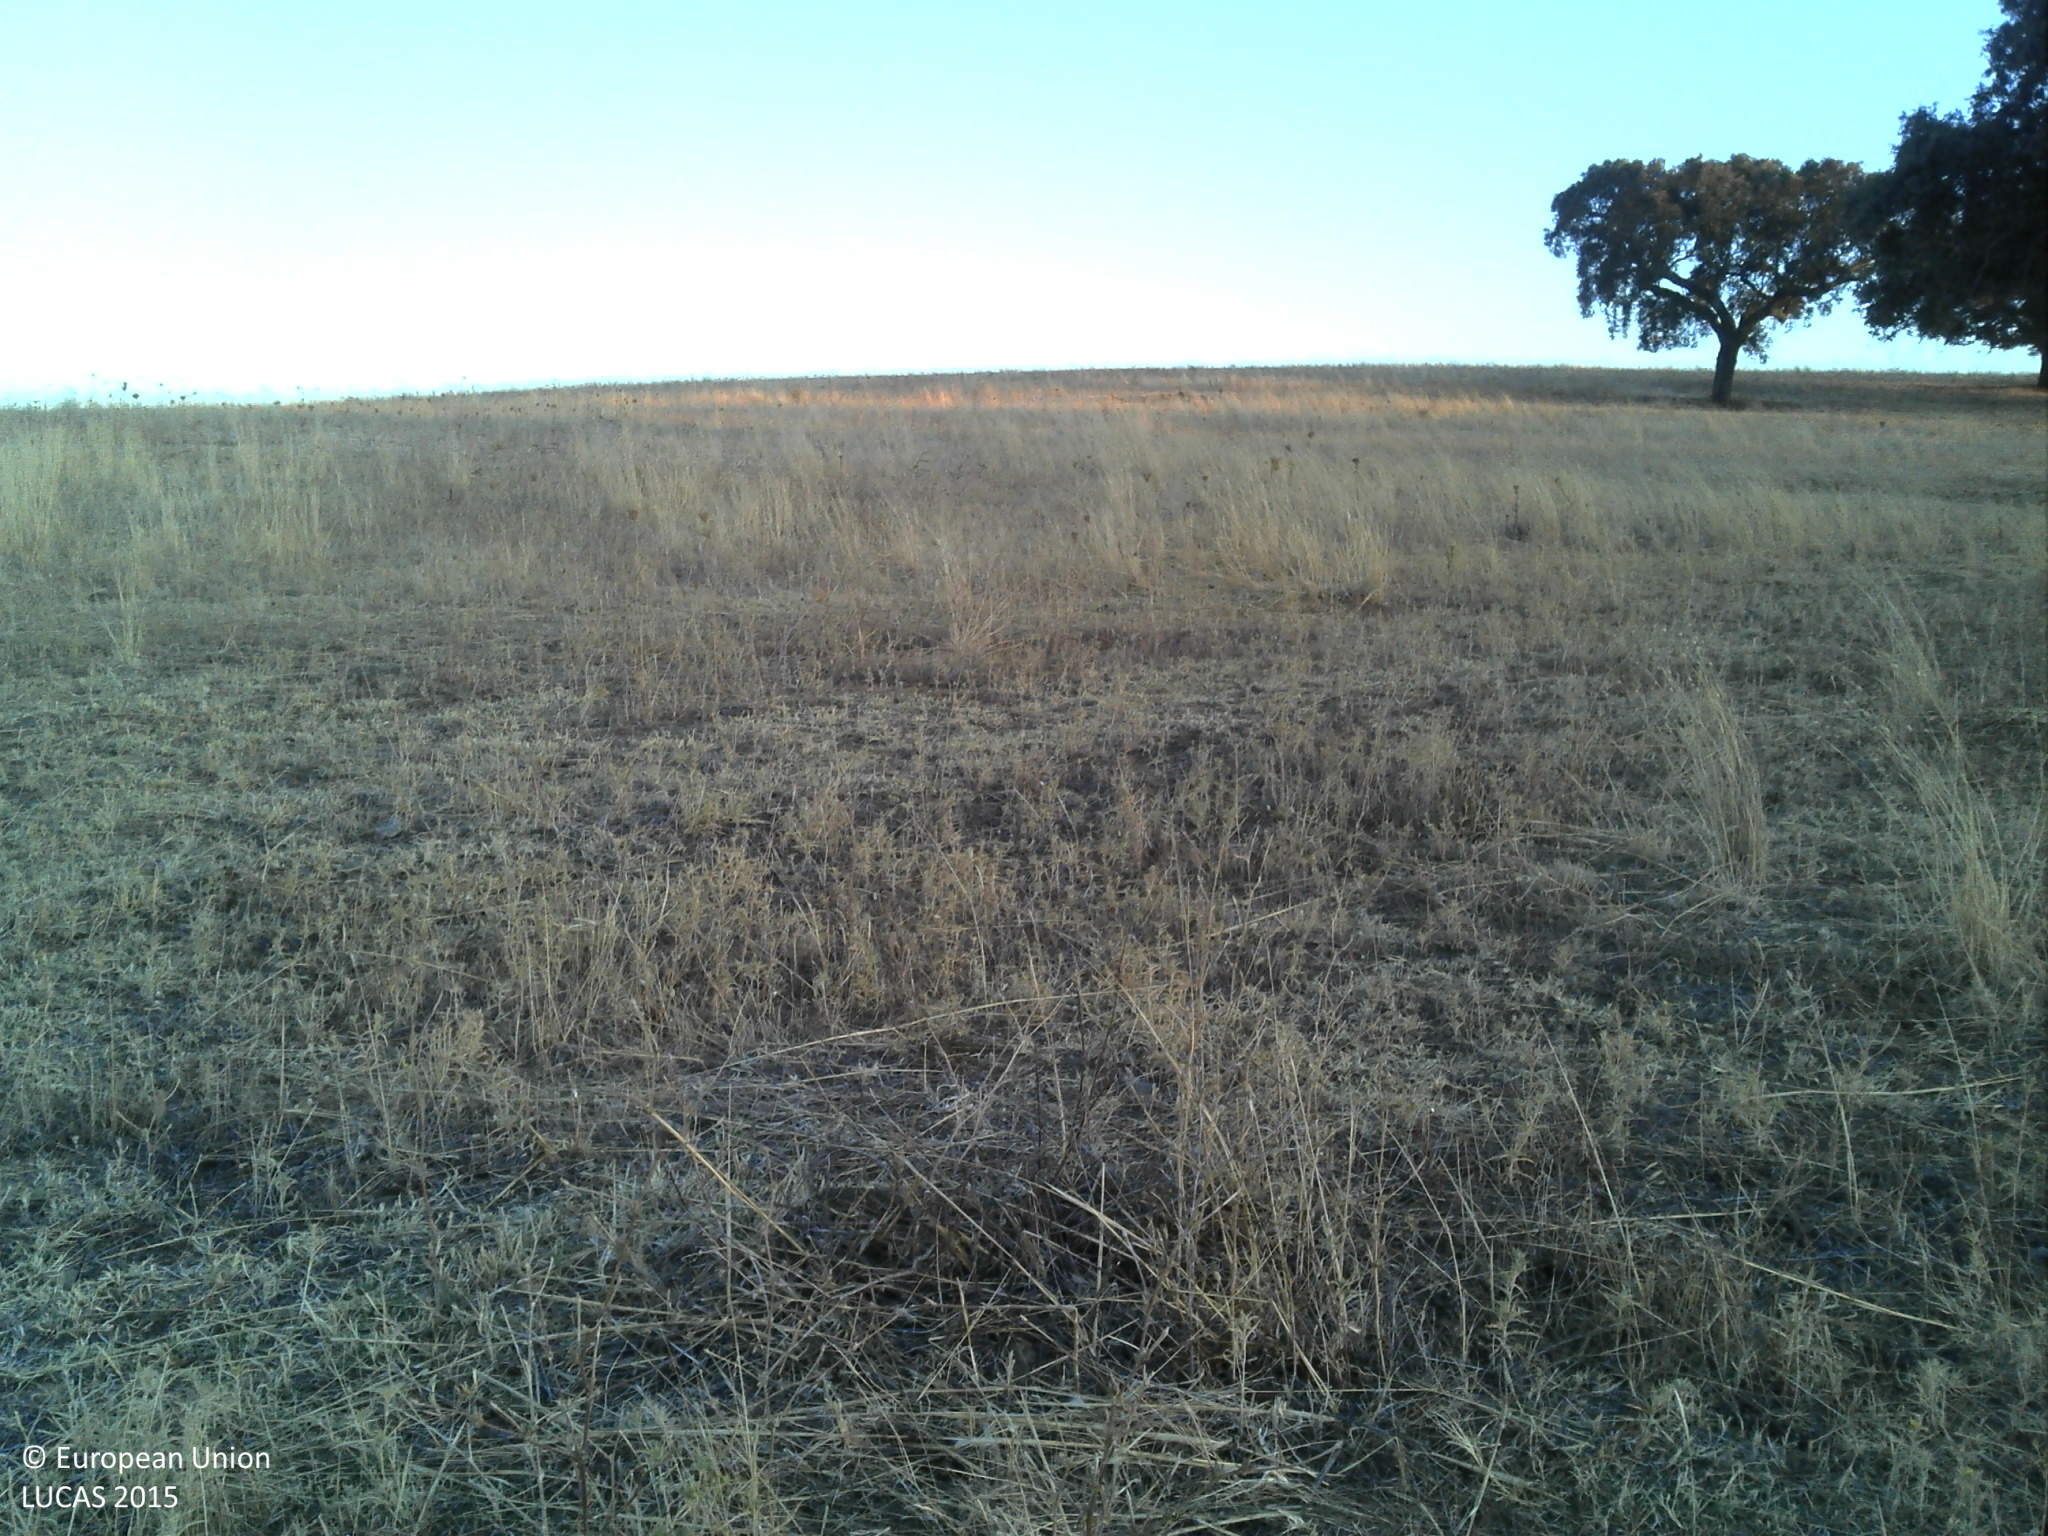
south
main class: Grassland
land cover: Grassland without tree/shrub cover
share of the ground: 50 - 75 %
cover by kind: herbaceous plants 60 %, unconsolidated bare surface 40 %
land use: Agriculture (excluding fallow land and kitchen gardens)
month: July
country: PT
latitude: 38.2338
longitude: -7.9123
